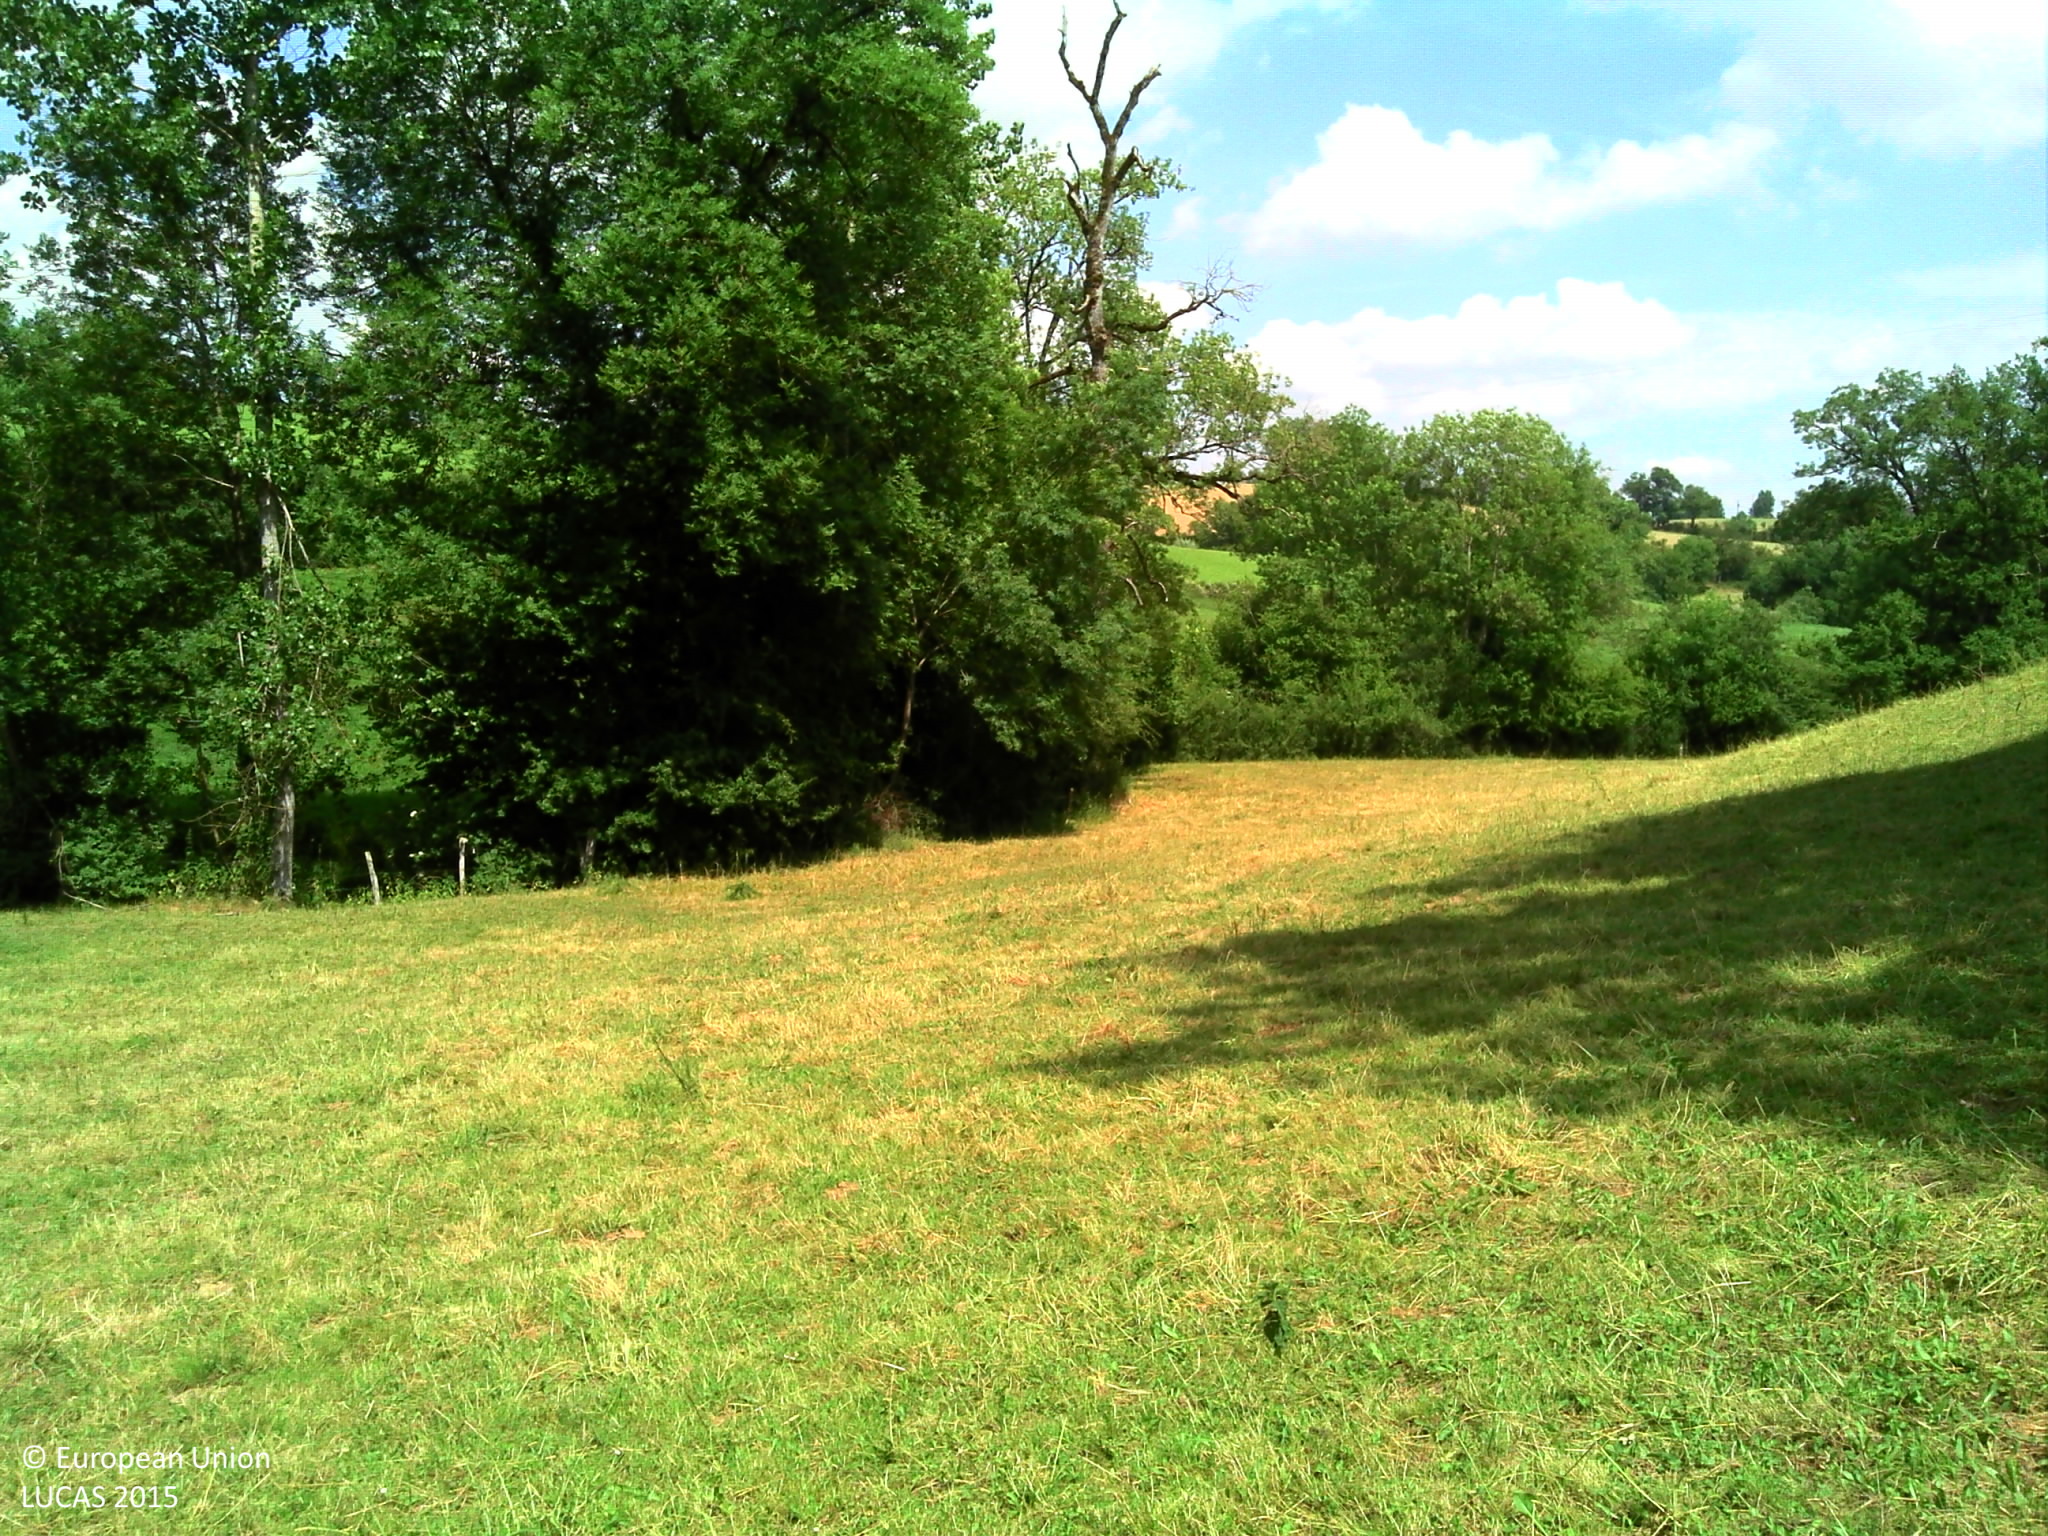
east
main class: Grassland
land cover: Grassland without tree/shrub cover
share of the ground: > 75 %
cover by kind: herbaceous plants 100 %
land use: Agriculture (excluding fallow land and kitchen gardens)
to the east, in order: Grassland without tree/shrub cover; Electric lines; Grassland without tree/shrub cover; Fences; Broadleaved woodland; Rivers and streams; Broadleaved woodland; Grassland without tree/shrub cover; Fences; Managed hedges; Temporary grasslands
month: June
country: FR
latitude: 44.2445
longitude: 2.0502
